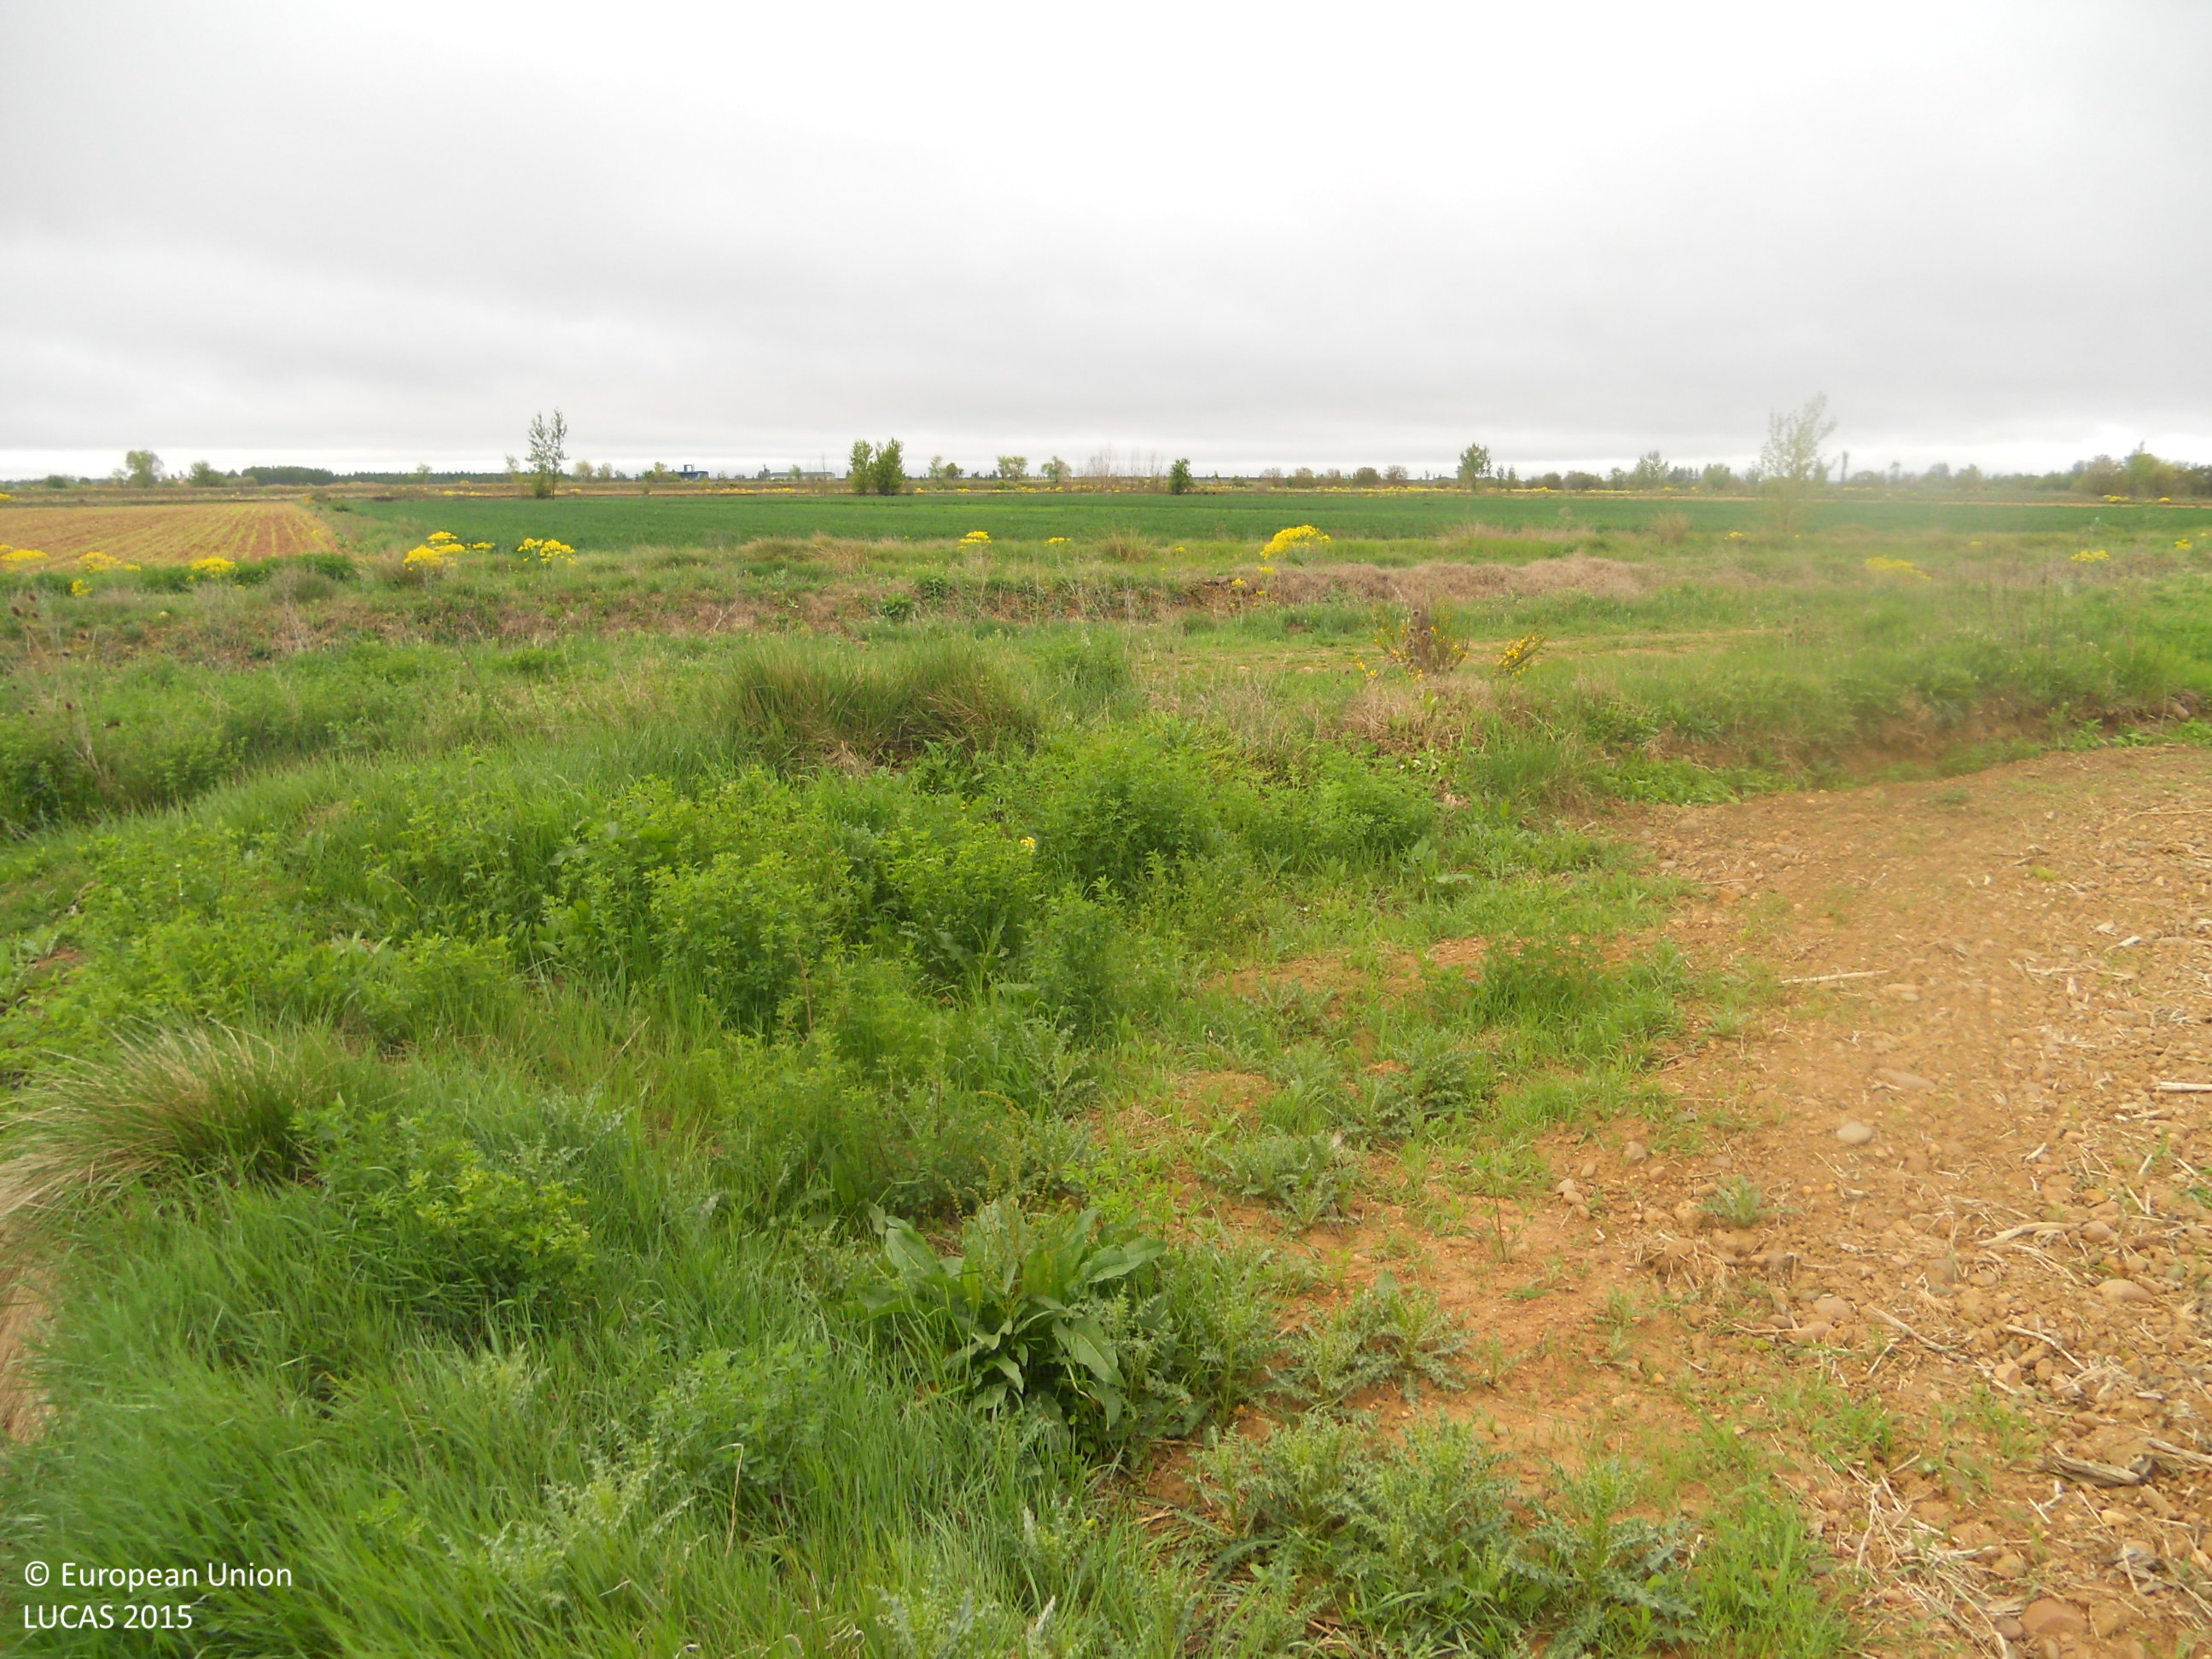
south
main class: Cropland
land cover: Common wheat
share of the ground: > 75 %
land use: Agriculture (excluding fallow land and kitchen gardens)
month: May
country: ES
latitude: 42.4763
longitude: -5.4067
